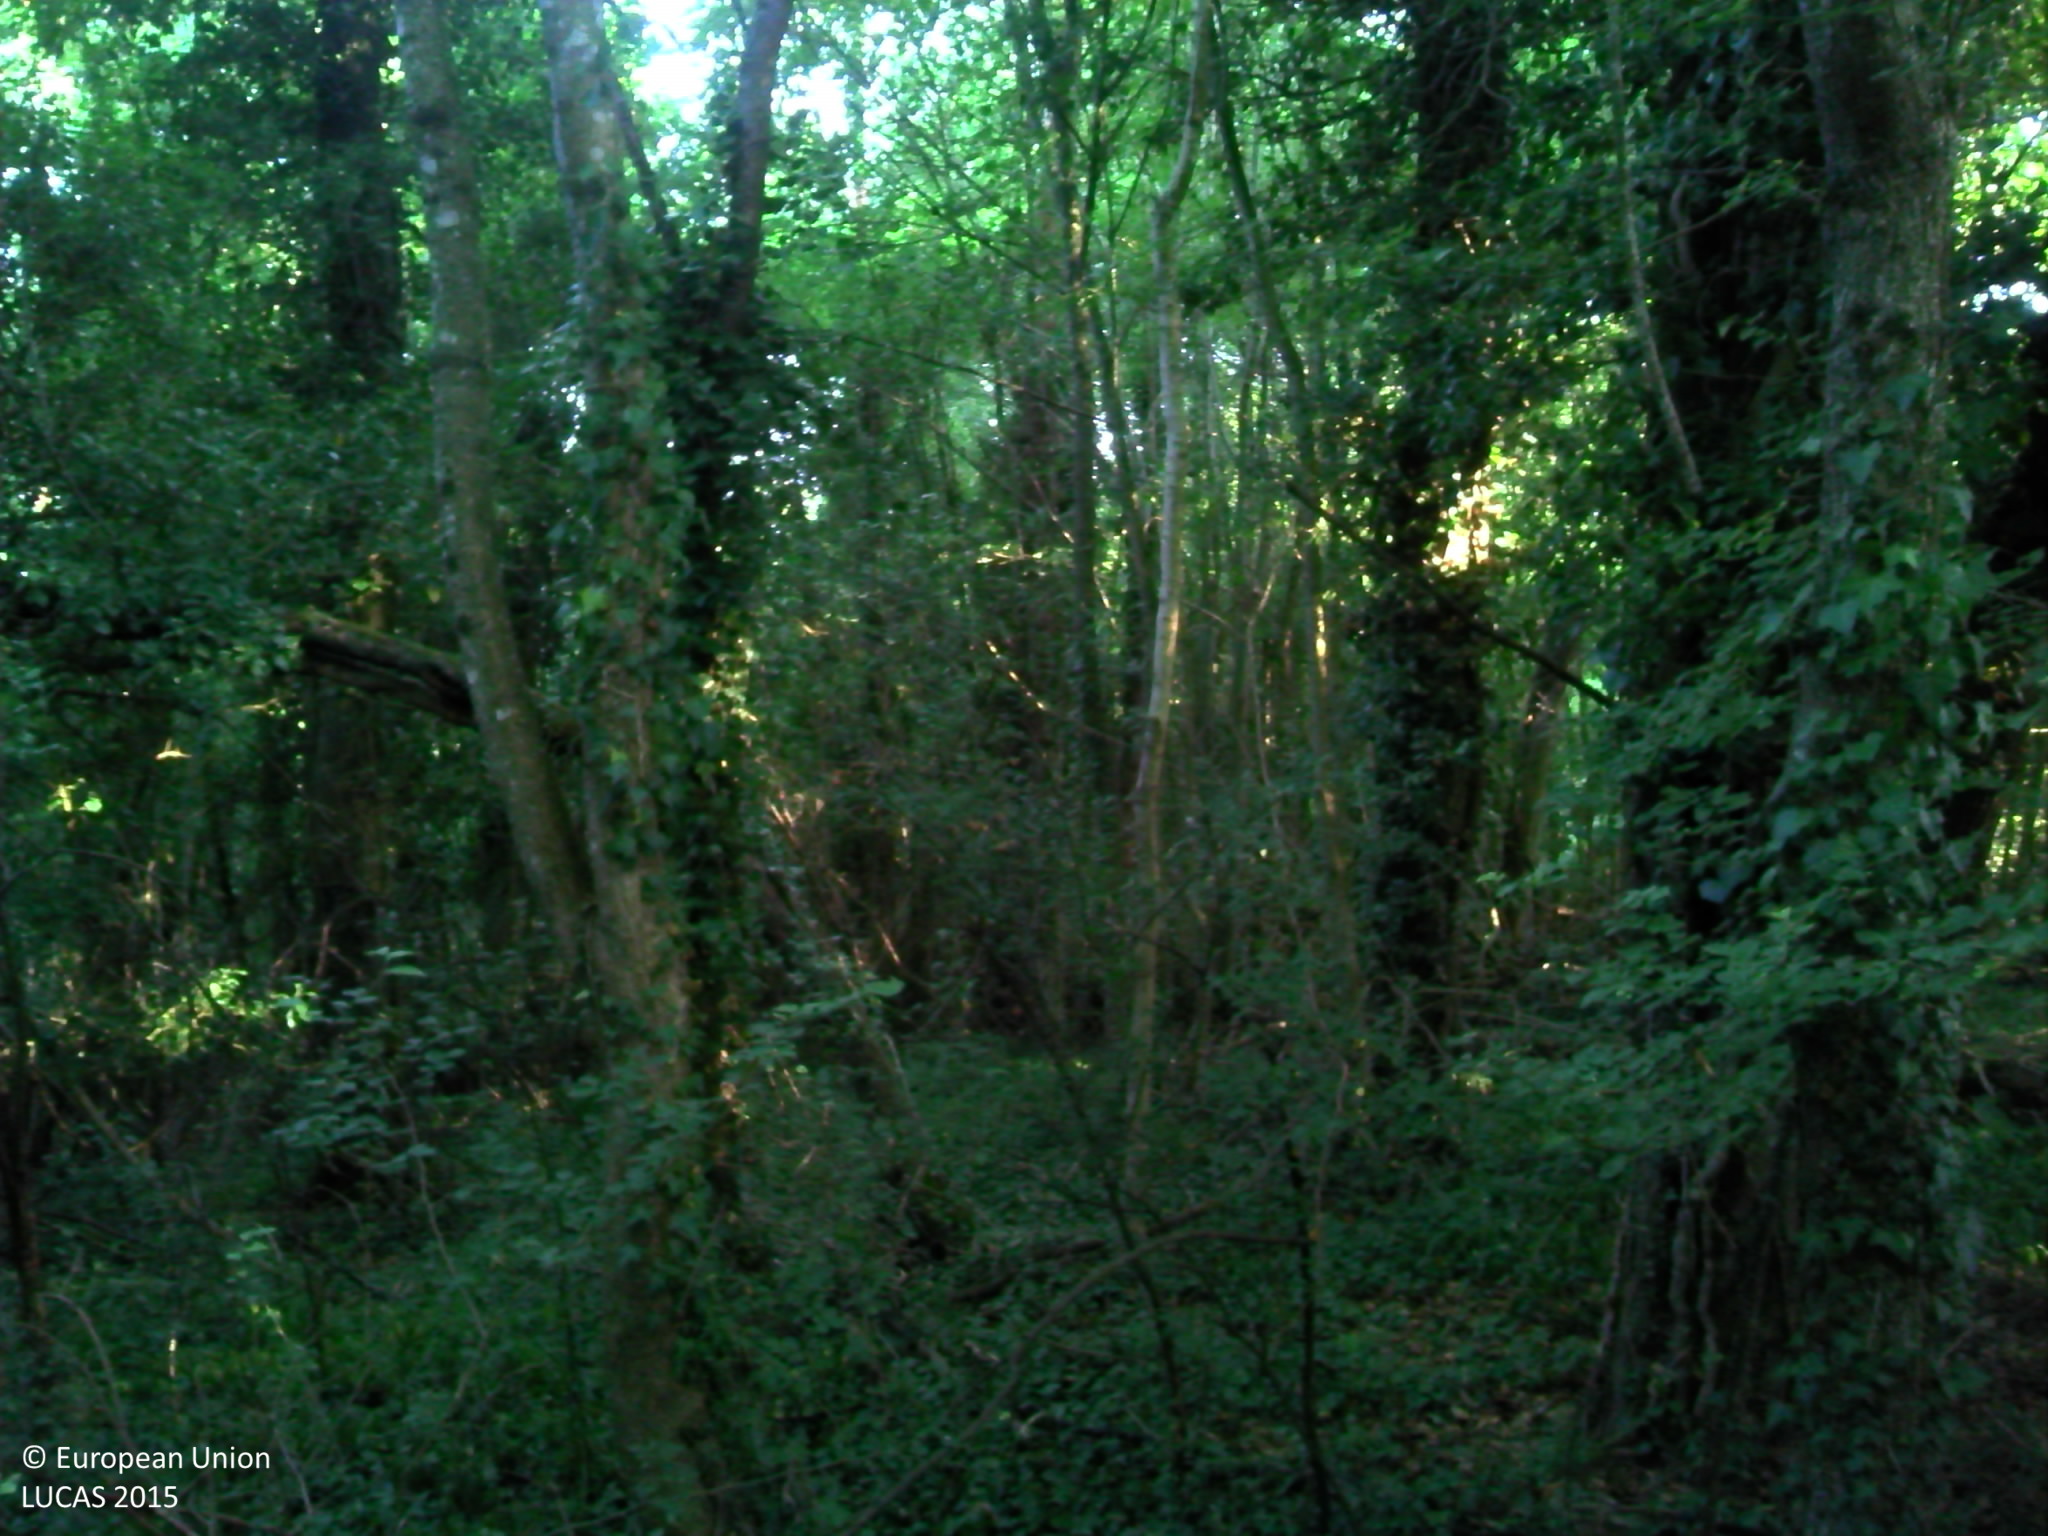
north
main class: Woodland
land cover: Broadleaved woodland
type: mesophytic deciduous forest
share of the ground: > 75 %
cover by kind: broadleaved forest trees 100 %
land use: Semi-natural and natural areas not in use
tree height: > 5 m
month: July
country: FR
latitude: 46.8439
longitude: 3.2701
